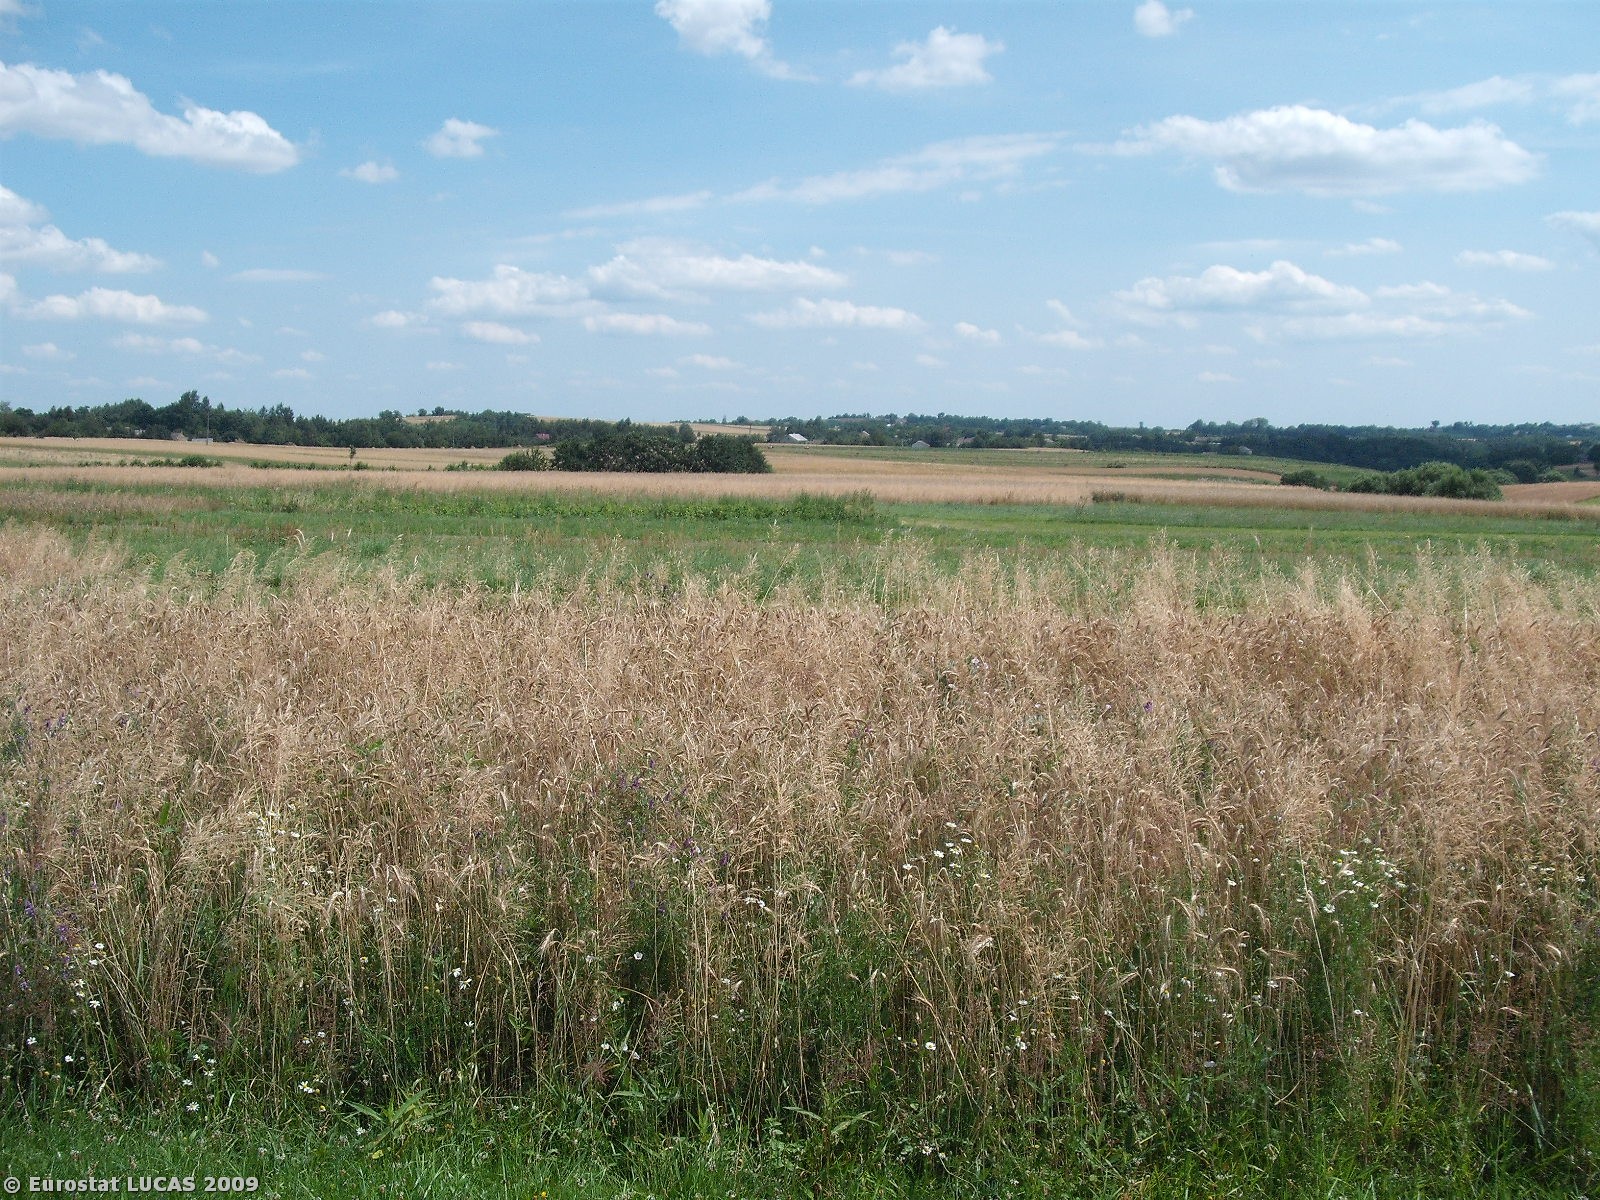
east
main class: Grassland
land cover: Grassland without tree/shrub cover
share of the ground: > 75 %
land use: Agriculture (excluding fallow land and kitchen gardens)
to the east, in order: Grassland without tree/shrub cover; Triticale; Grassland without tree/shrub cover; Rye; Grass margins; Rye; Oats; Grassland without tree/shrub cover; Common wheat; Oats; Grass margins; Oats; Grass margins; Potatoes
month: July
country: PL
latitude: 50.6795
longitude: 21.2417
